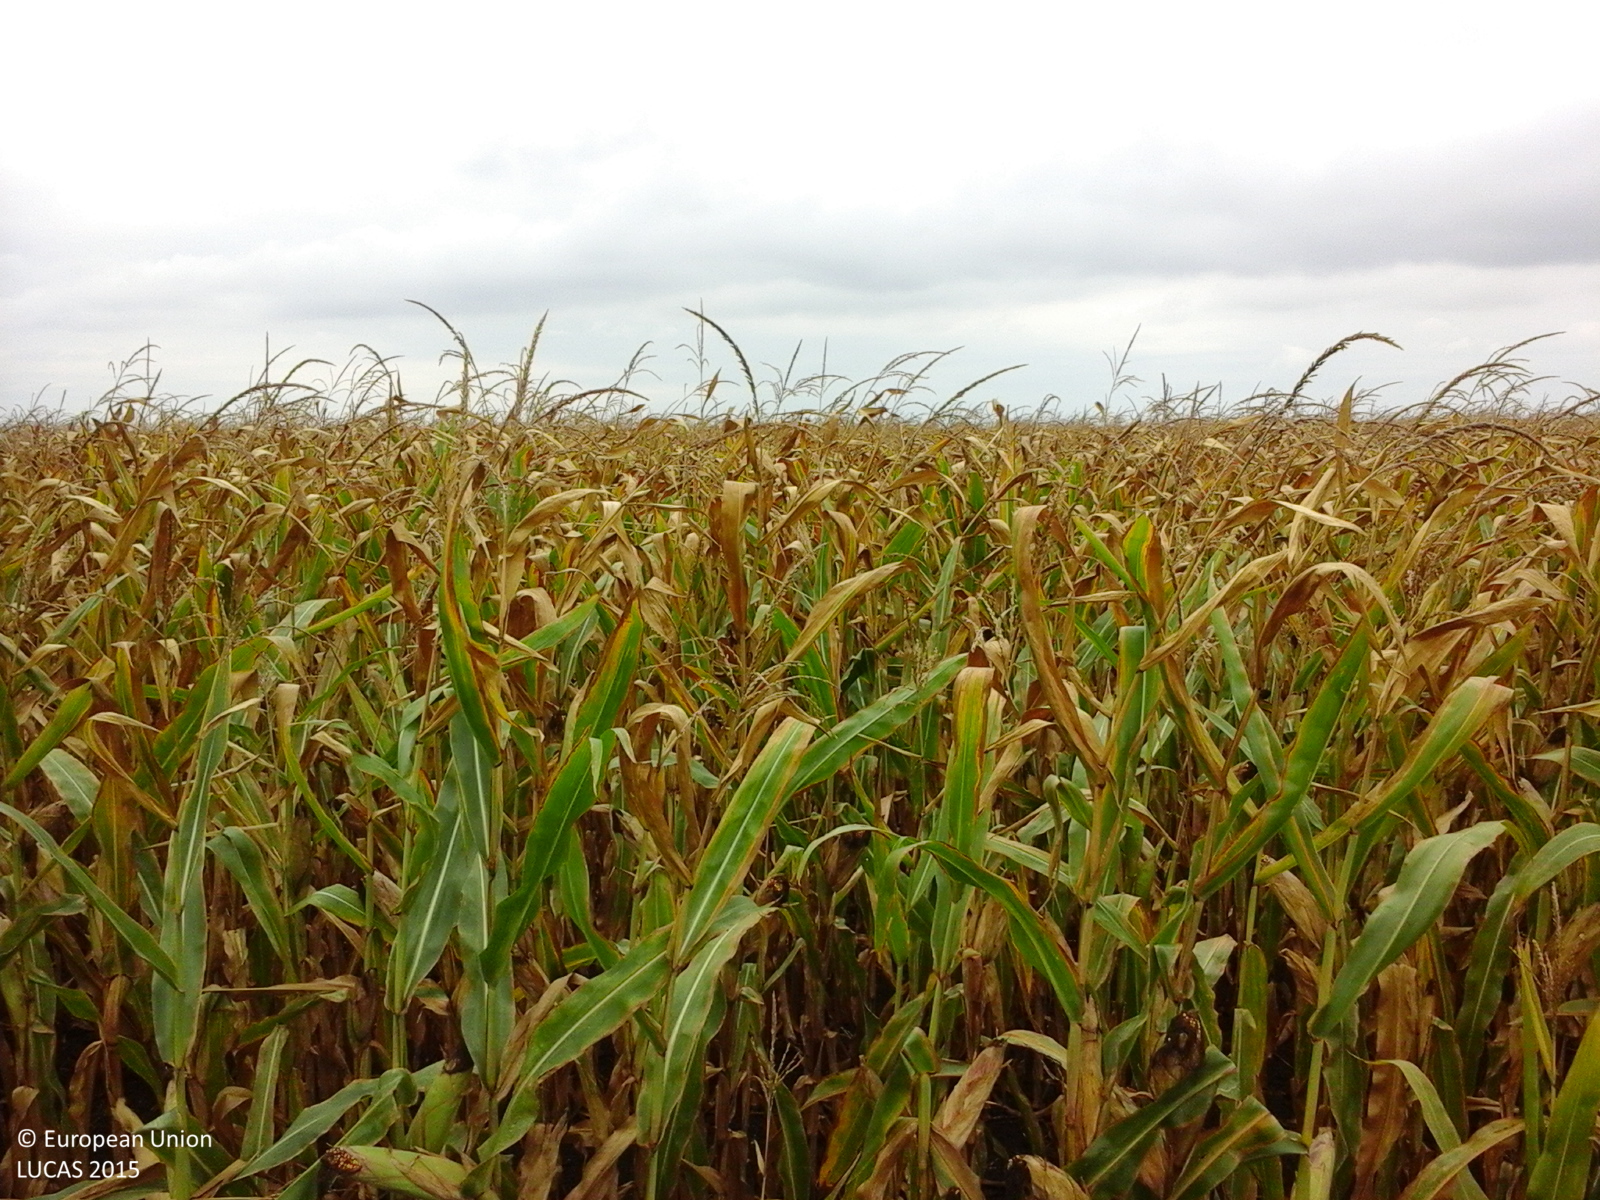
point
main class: Cropland
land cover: Maize
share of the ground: > 75 %
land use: Agriculture (excluding fallow land and kitchen gardens)
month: August
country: RO
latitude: 45.8236
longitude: 20.7738
